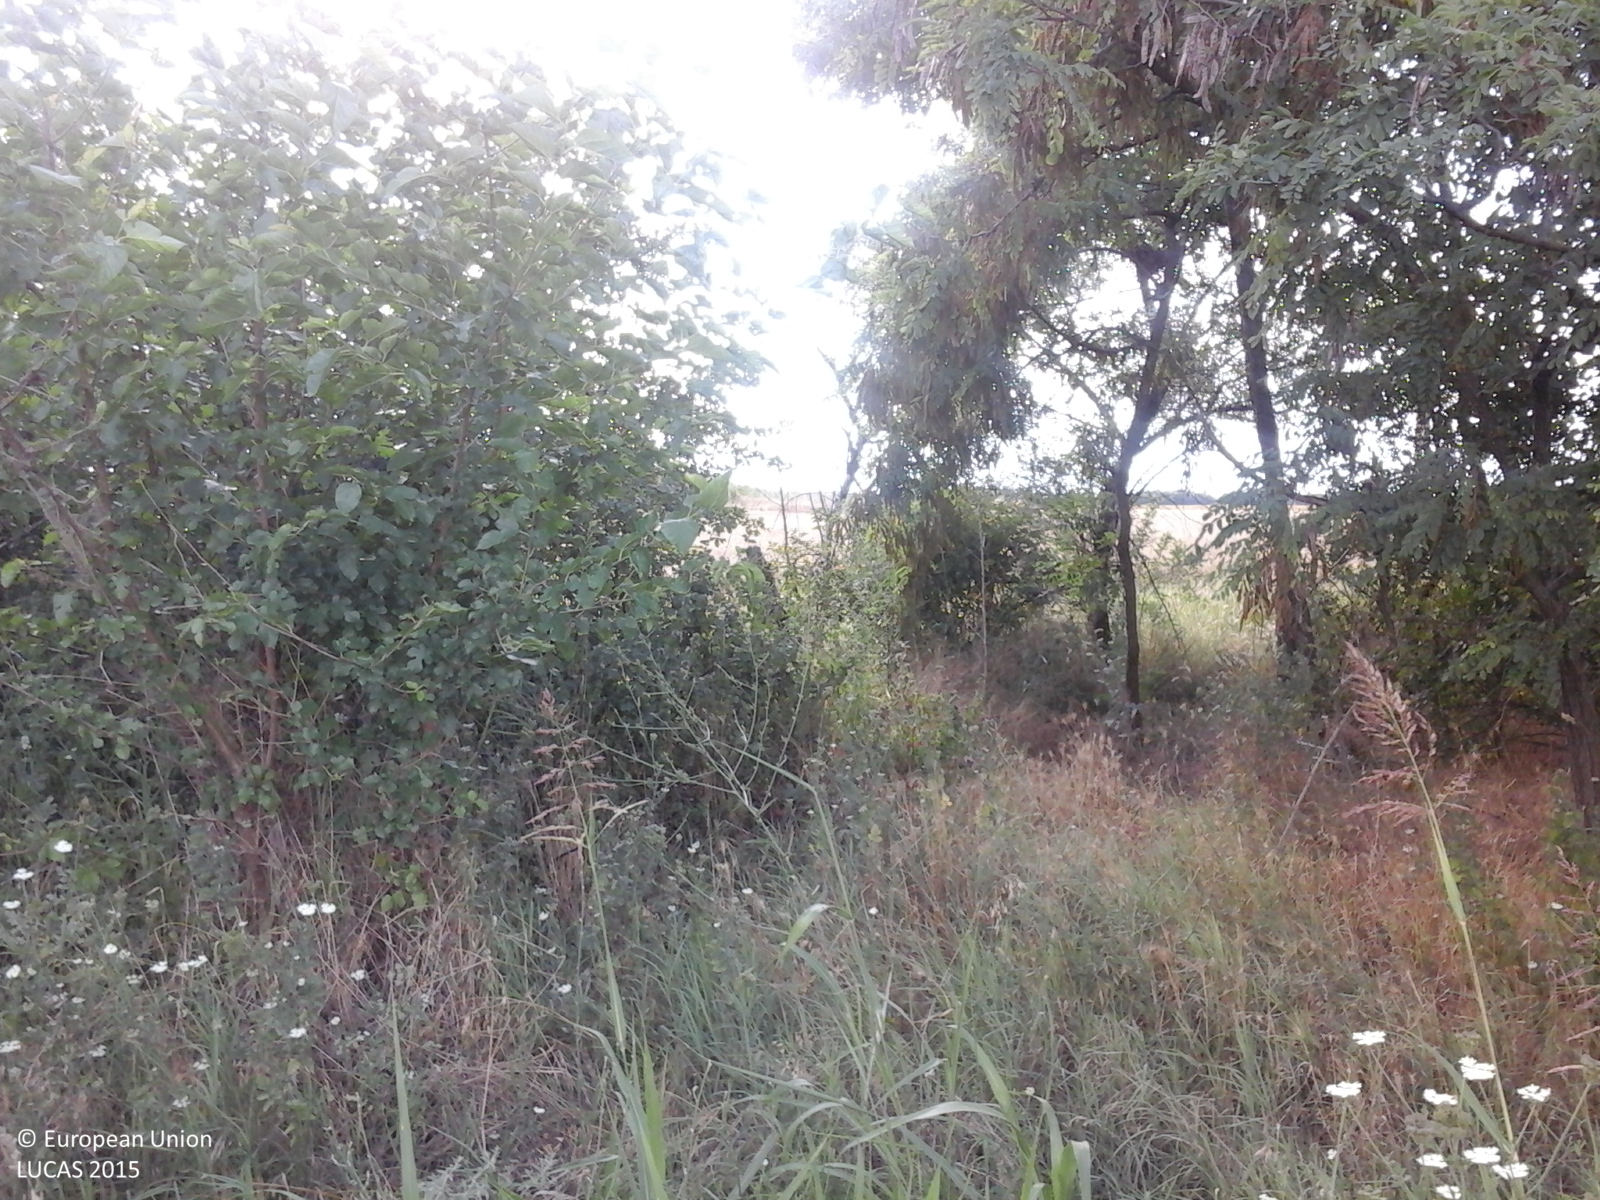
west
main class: Cropland
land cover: Maize
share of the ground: > 75 %
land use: Agriculture (excluding fallow land and kitchen gardens)
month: July
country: RO
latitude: 43.7660
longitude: 24.2331
